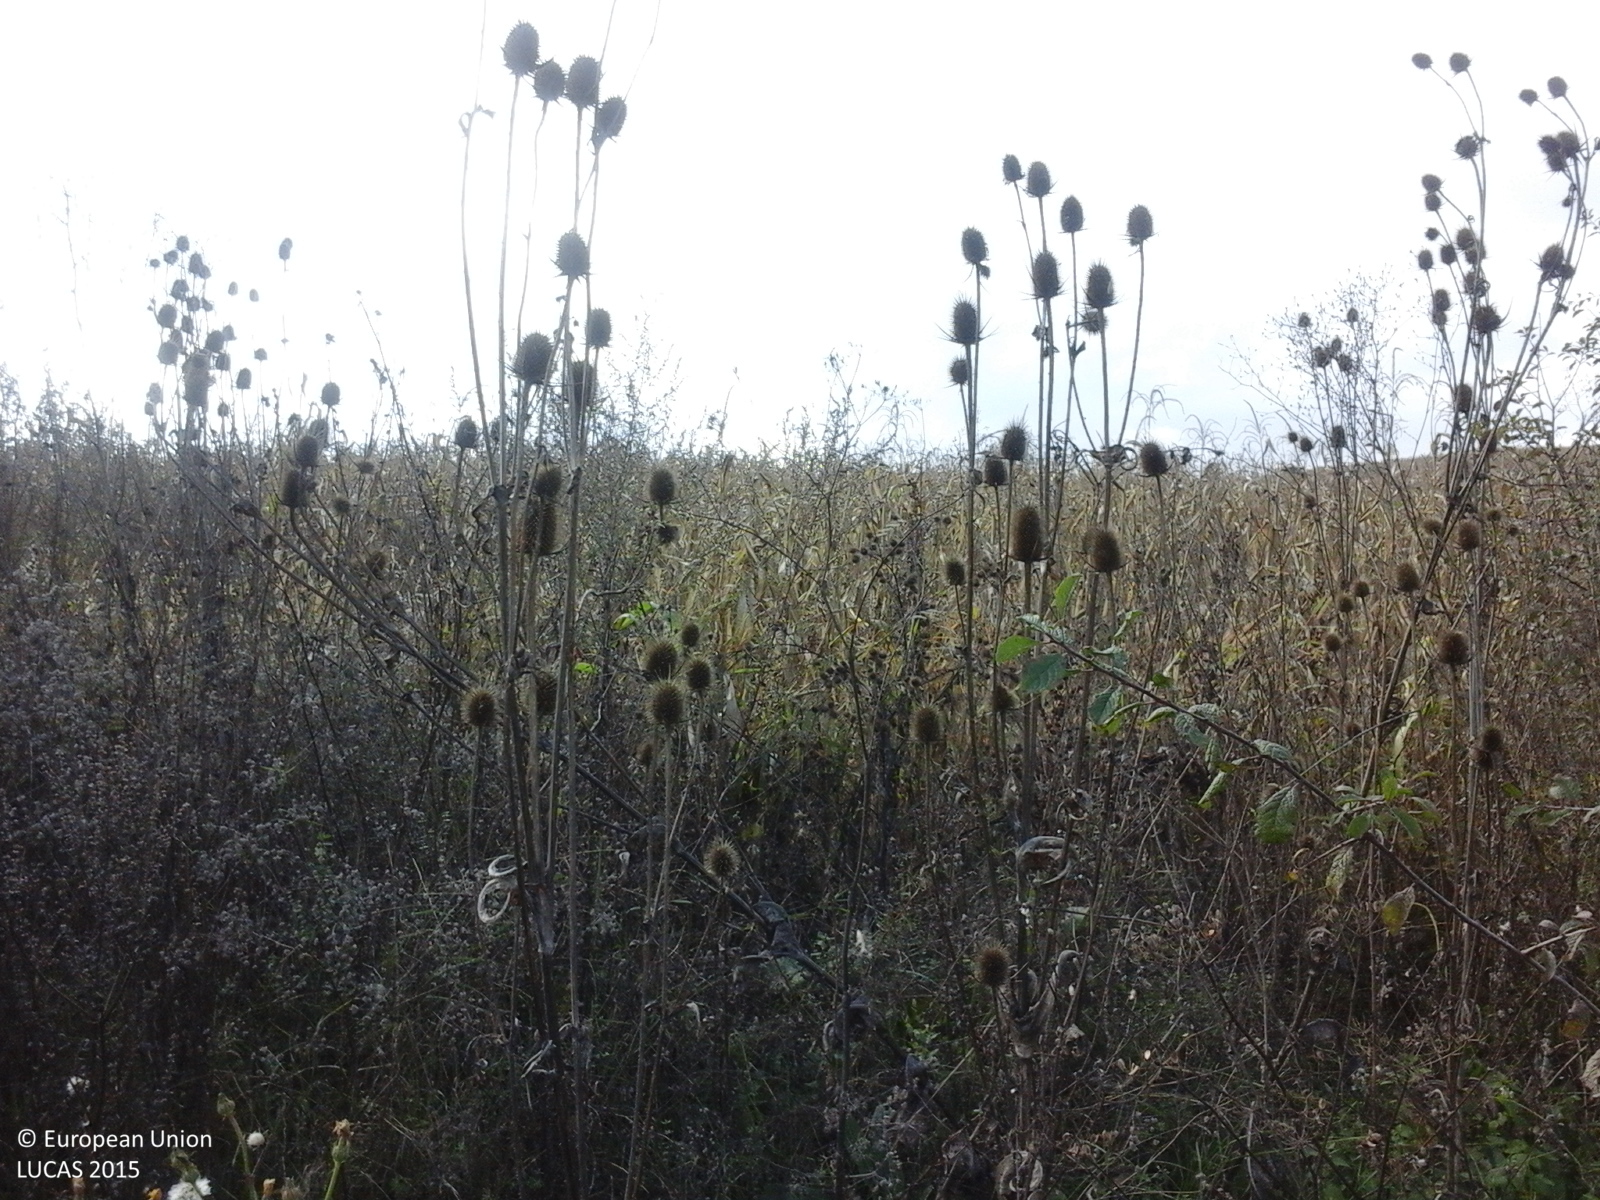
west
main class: Cropland
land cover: Maize
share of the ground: > 75 %
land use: Agriculture (excluding fallow land and kitchen gardens)
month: October
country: RO
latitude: 46.2487
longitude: 24.1248
